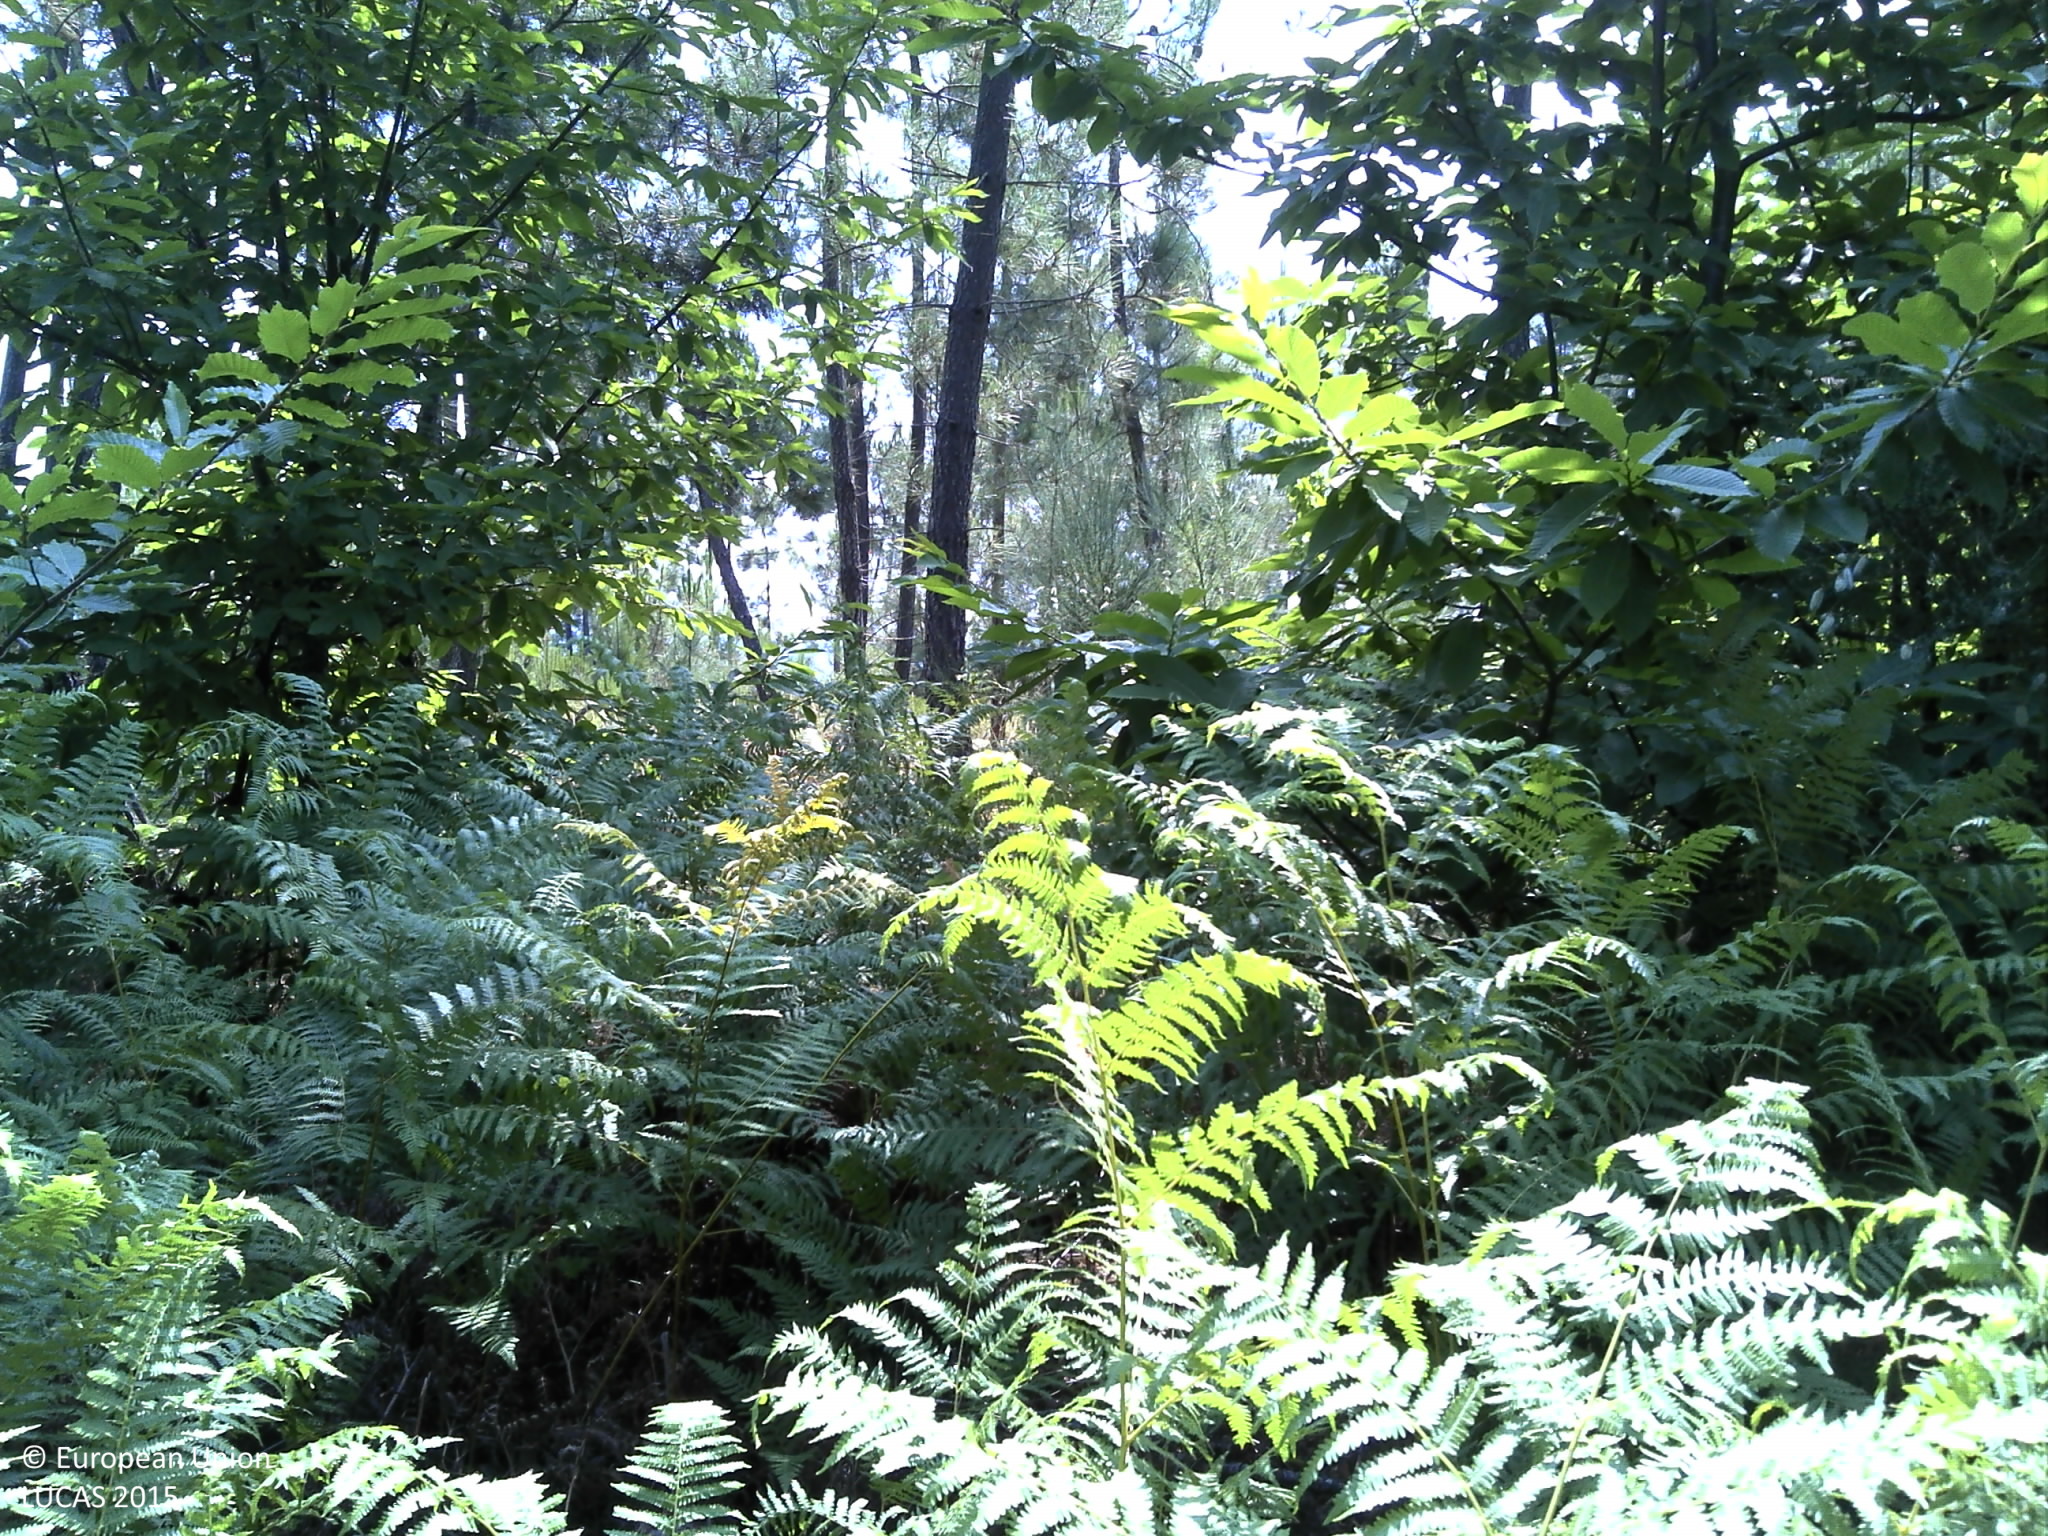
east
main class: Woodland
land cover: Pine dominated coniferous woodland
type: coniferous forest of the mediterranean region
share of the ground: 25 - 50 %
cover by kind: shrubs 70 %, coniferous forest trees 30 %
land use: Forestry
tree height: > 5 m
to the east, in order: Pine dominated coniferous woodland; Shrubland without tree cover; Pine dominated coniferous woodland; Tracks; Shrubland with sparse tree cover; Pine dominated coniferous woodland; Shrubland with sparse tree cover; Tracks; Shrubland with sparse tree cover; Pine dominated coniferous woodland; Shrubland without tree cover; Pine dominated coniferous woodland; Shrubland with sparse tree cover
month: June
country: PT
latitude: 41.2489
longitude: -7.5842
